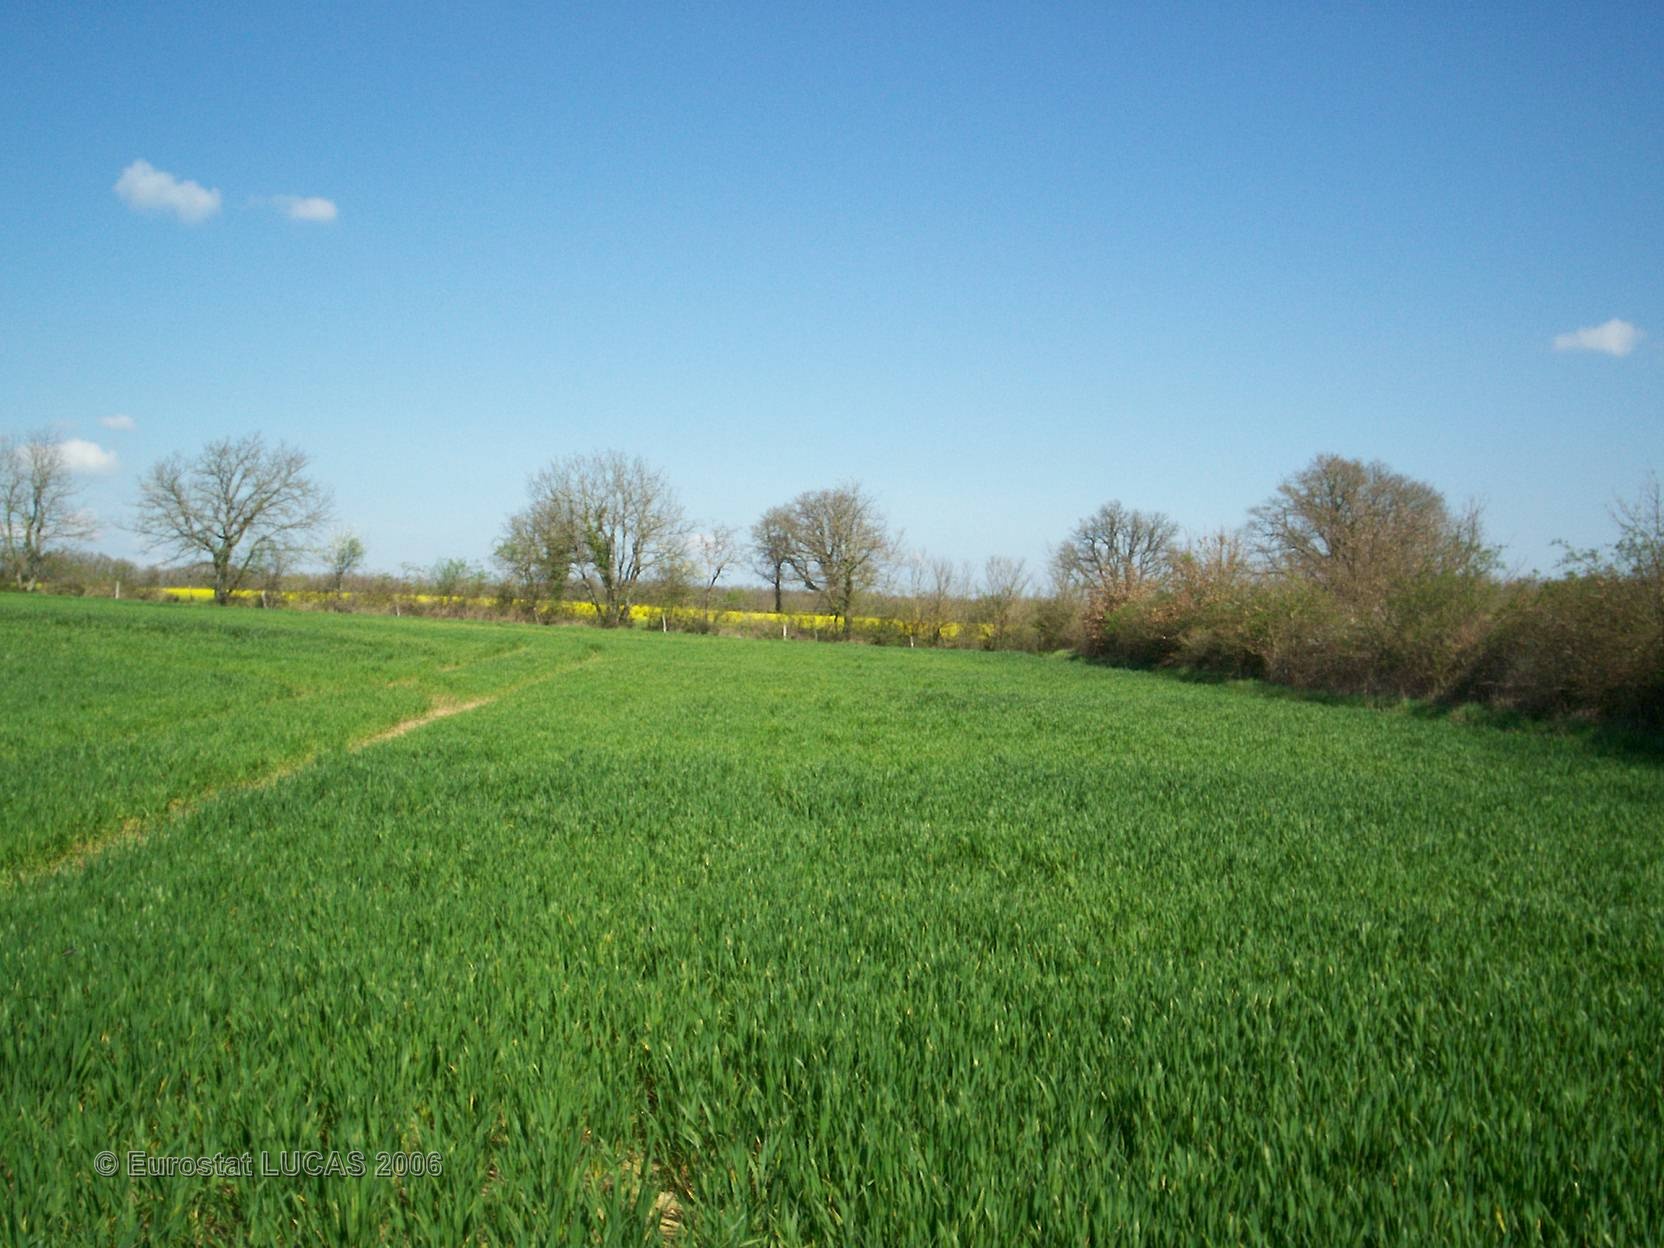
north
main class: Cropland
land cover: Barley
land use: Agriculture (excluding fallow land and kitchen gardens)
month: April
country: FR
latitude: 46.4951
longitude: 0.9832
